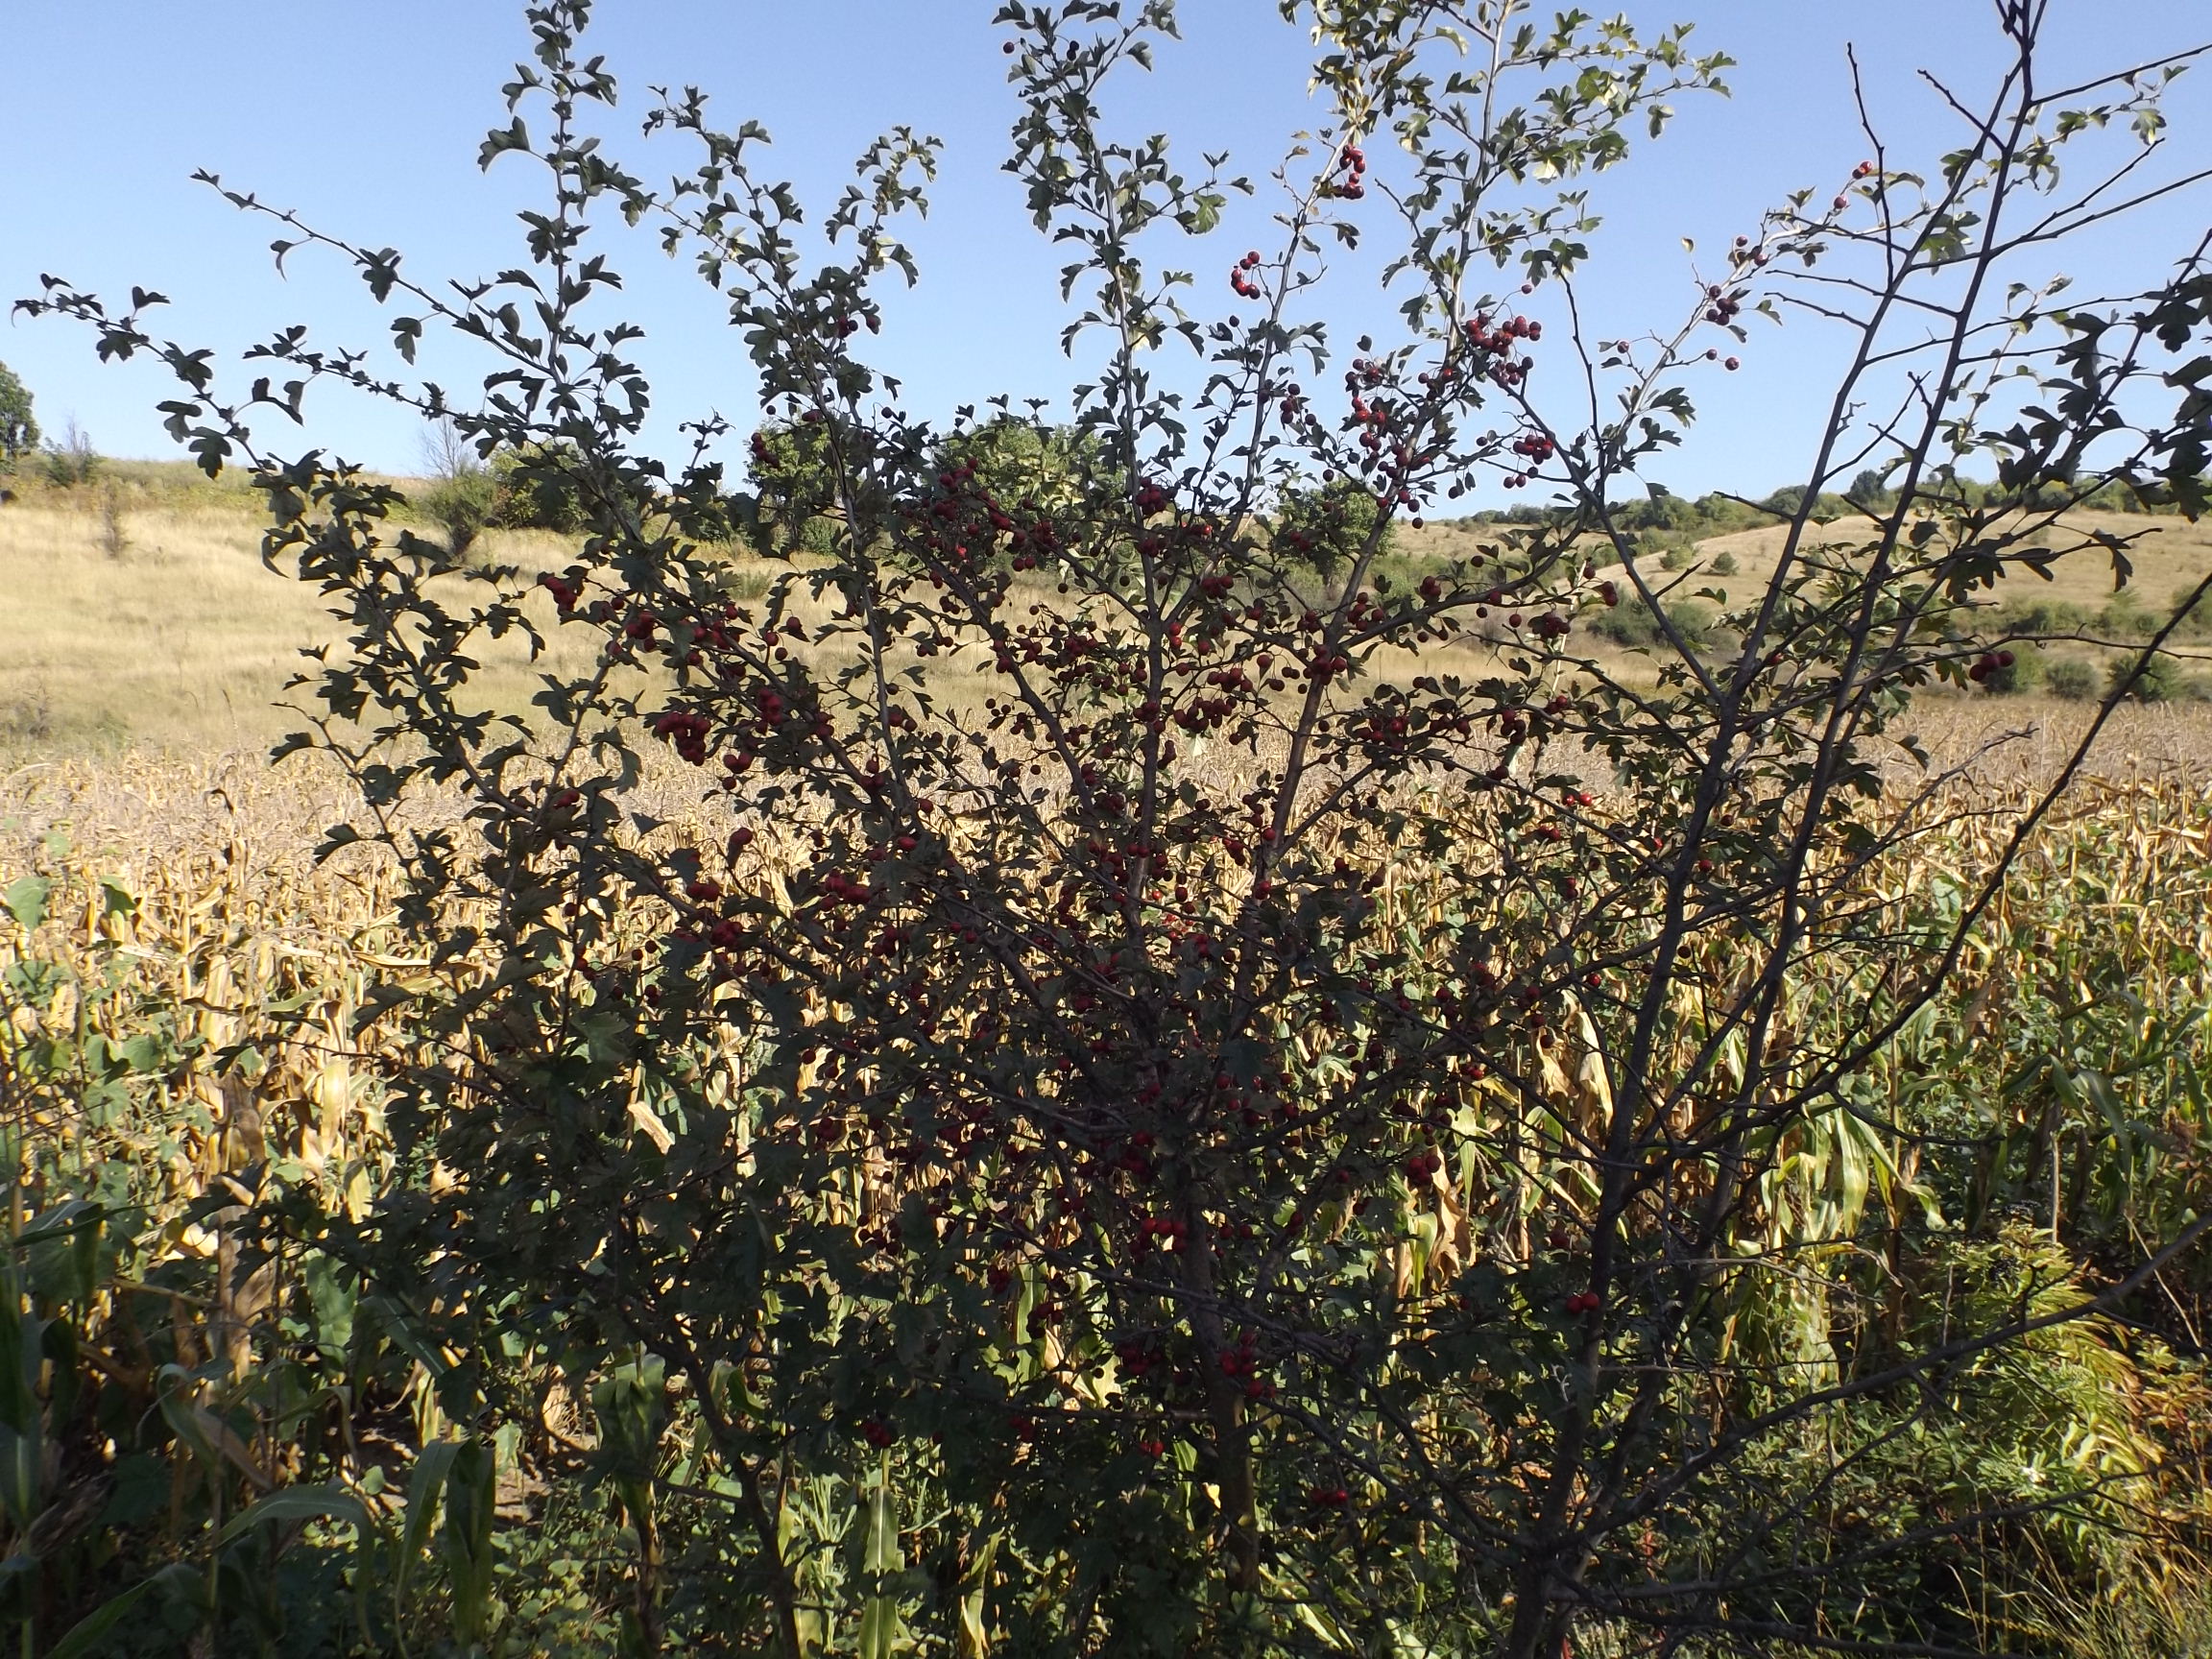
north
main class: Grassland
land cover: Grassland with sparse tree/shrub cover
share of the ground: > 75 %
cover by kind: herbaceous plants 85 %, shrubs 10 %, broadleaved forest trees 5 %
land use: Semi-natural and natural areas not in use
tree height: < 5 m
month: September
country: BG
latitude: 44.0609
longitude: 26.7583
